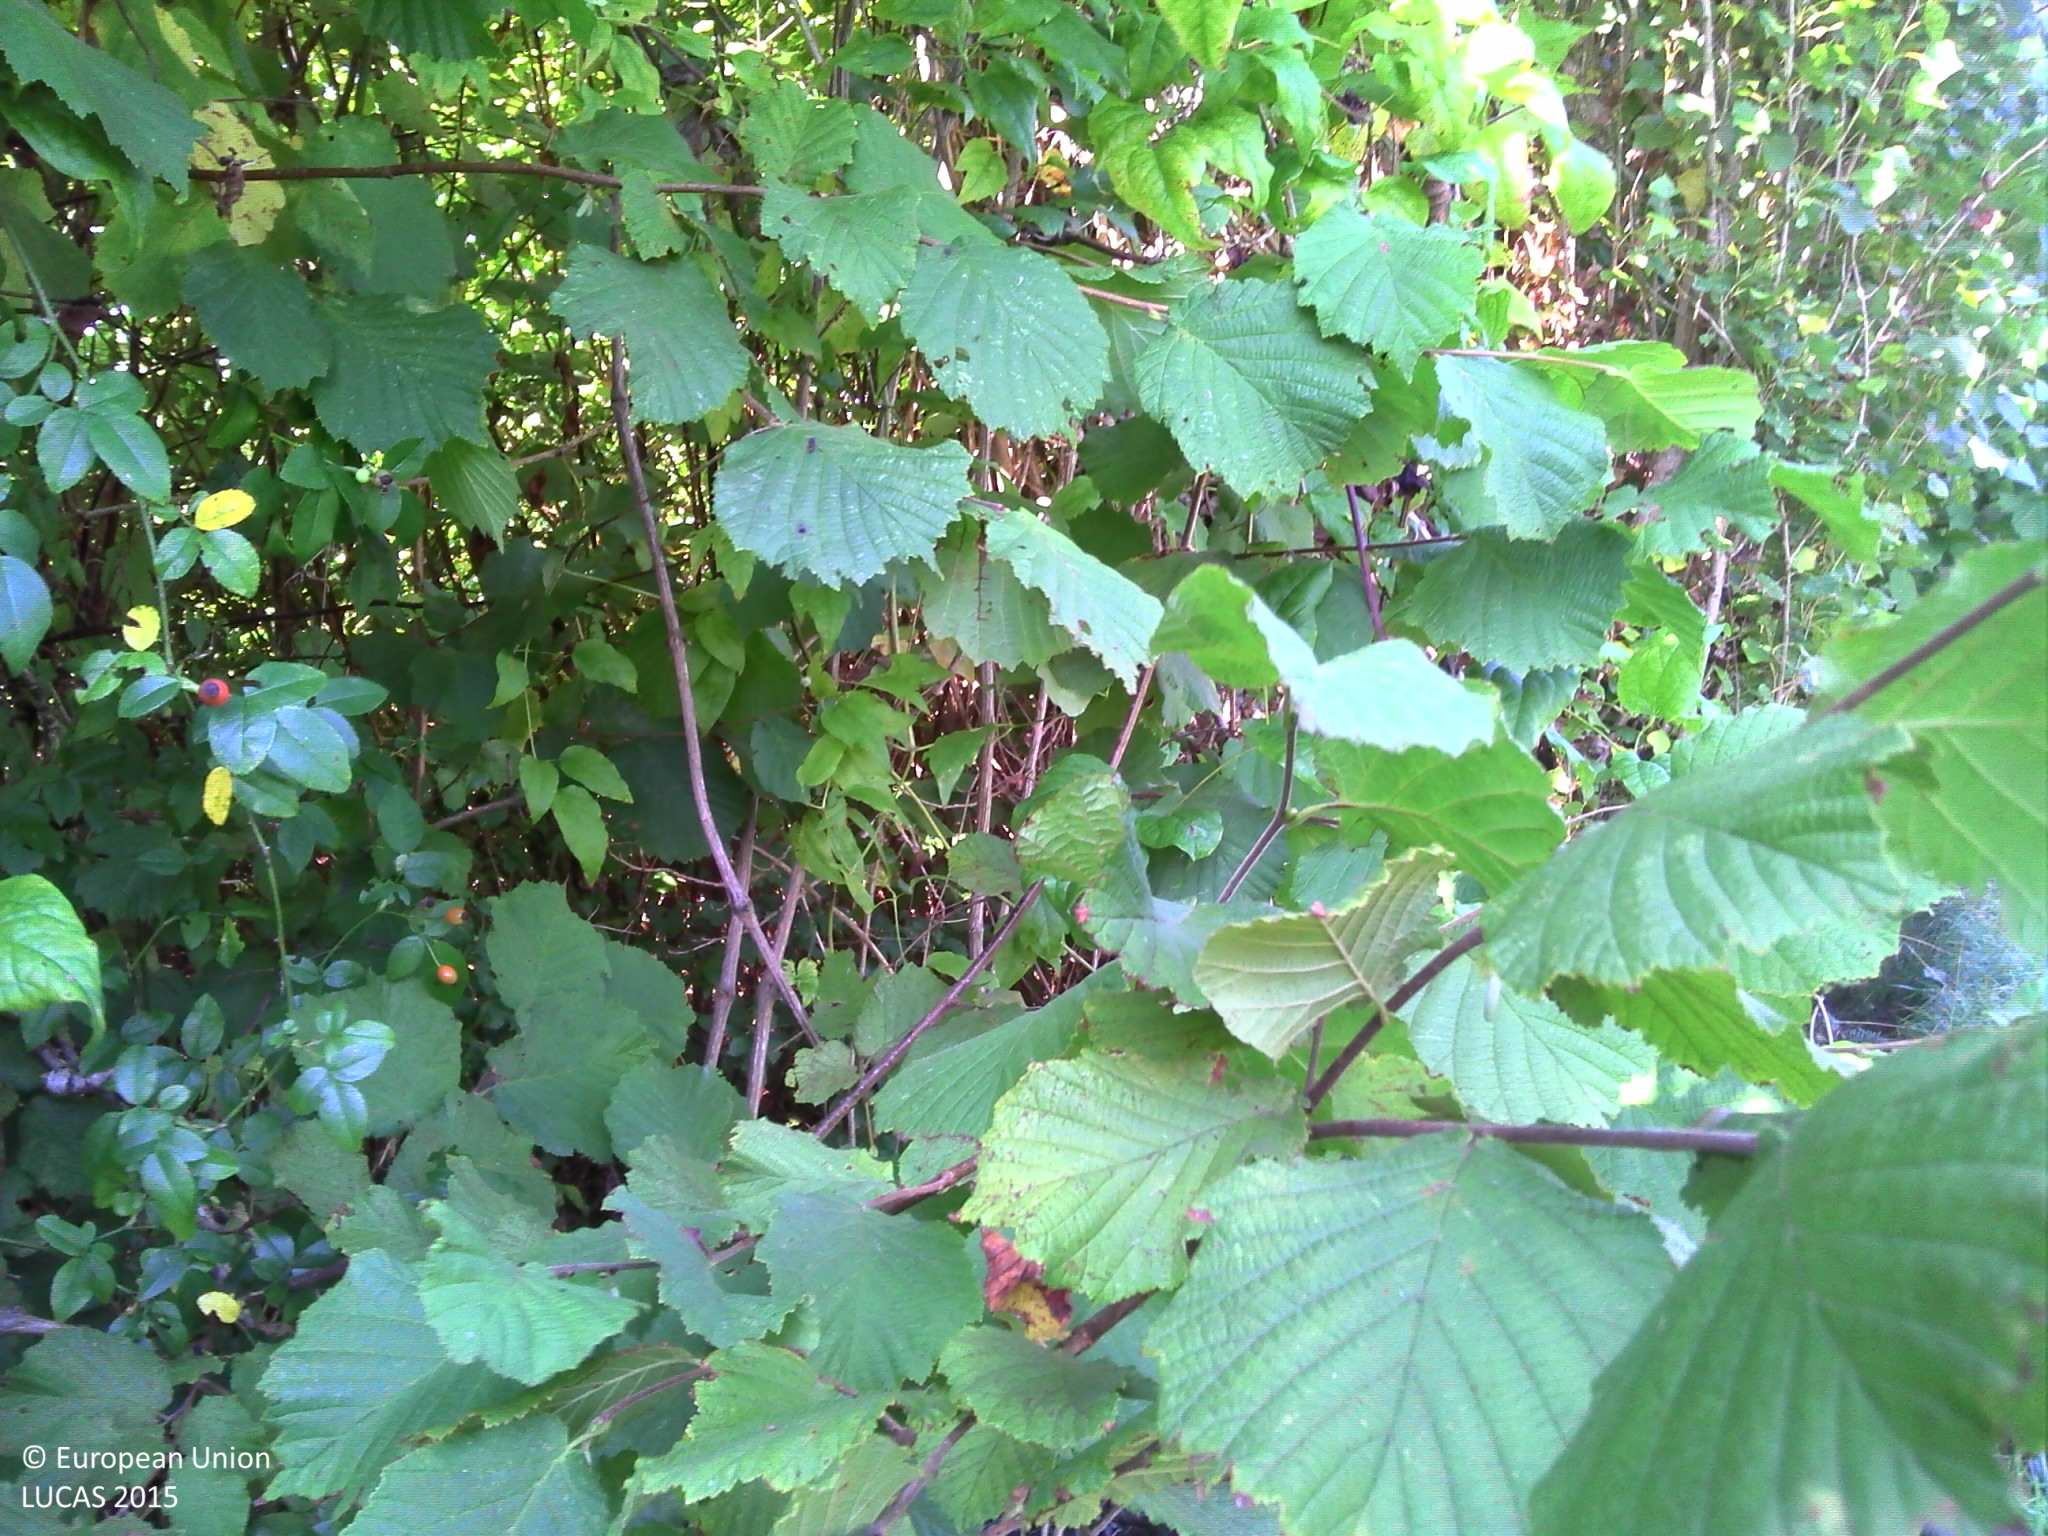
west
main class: Grassland
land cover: Grassland without tree/shrub cover
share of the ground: > 75 %
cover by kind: herbaceous plants 100 %
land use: Agriculture (excluding fallow land and kitchen gardens)
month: September
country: FR
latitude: 43.2453
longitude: -1.0845
